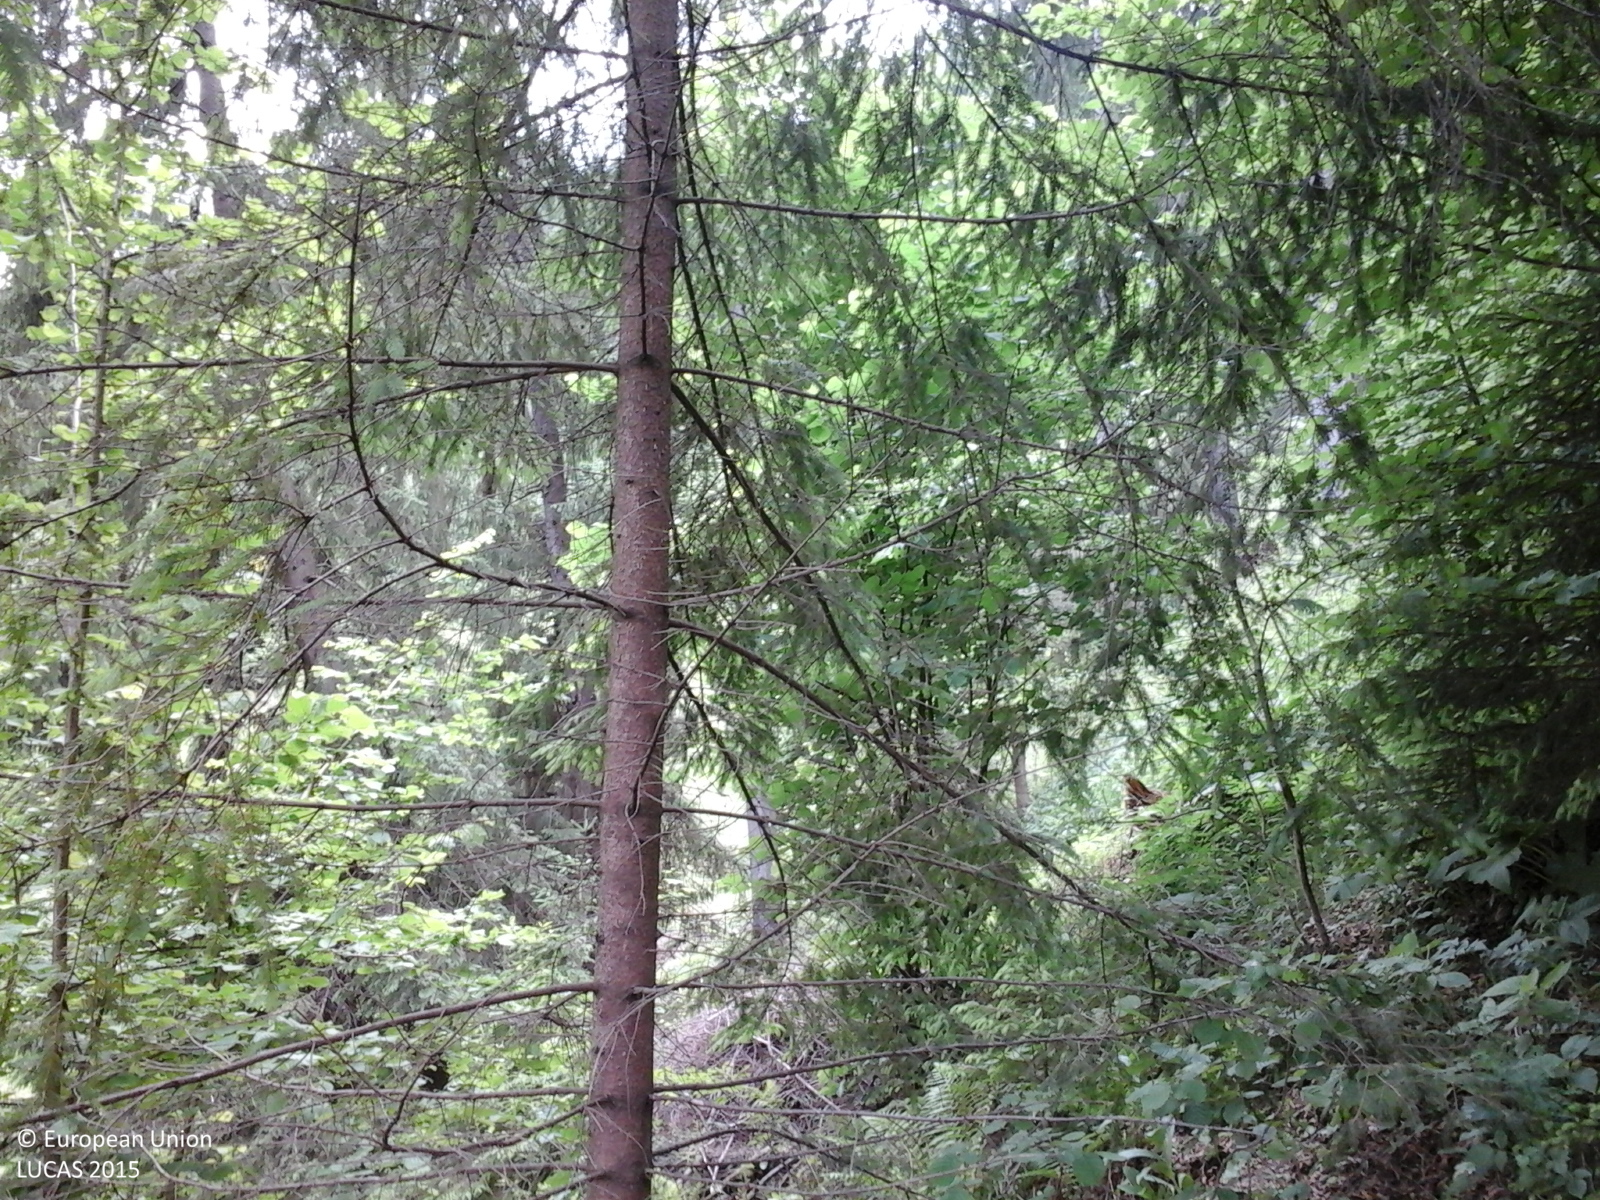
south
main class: Woodland
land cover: Spruce dominated coniferous woodland
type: alpine coniferous forest
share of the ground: > 75 %
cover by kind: coniferous forest trees 100 %
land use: Forestry
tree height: > 5 m
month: June
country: RO
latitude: 47.1692
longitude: 25.7804
